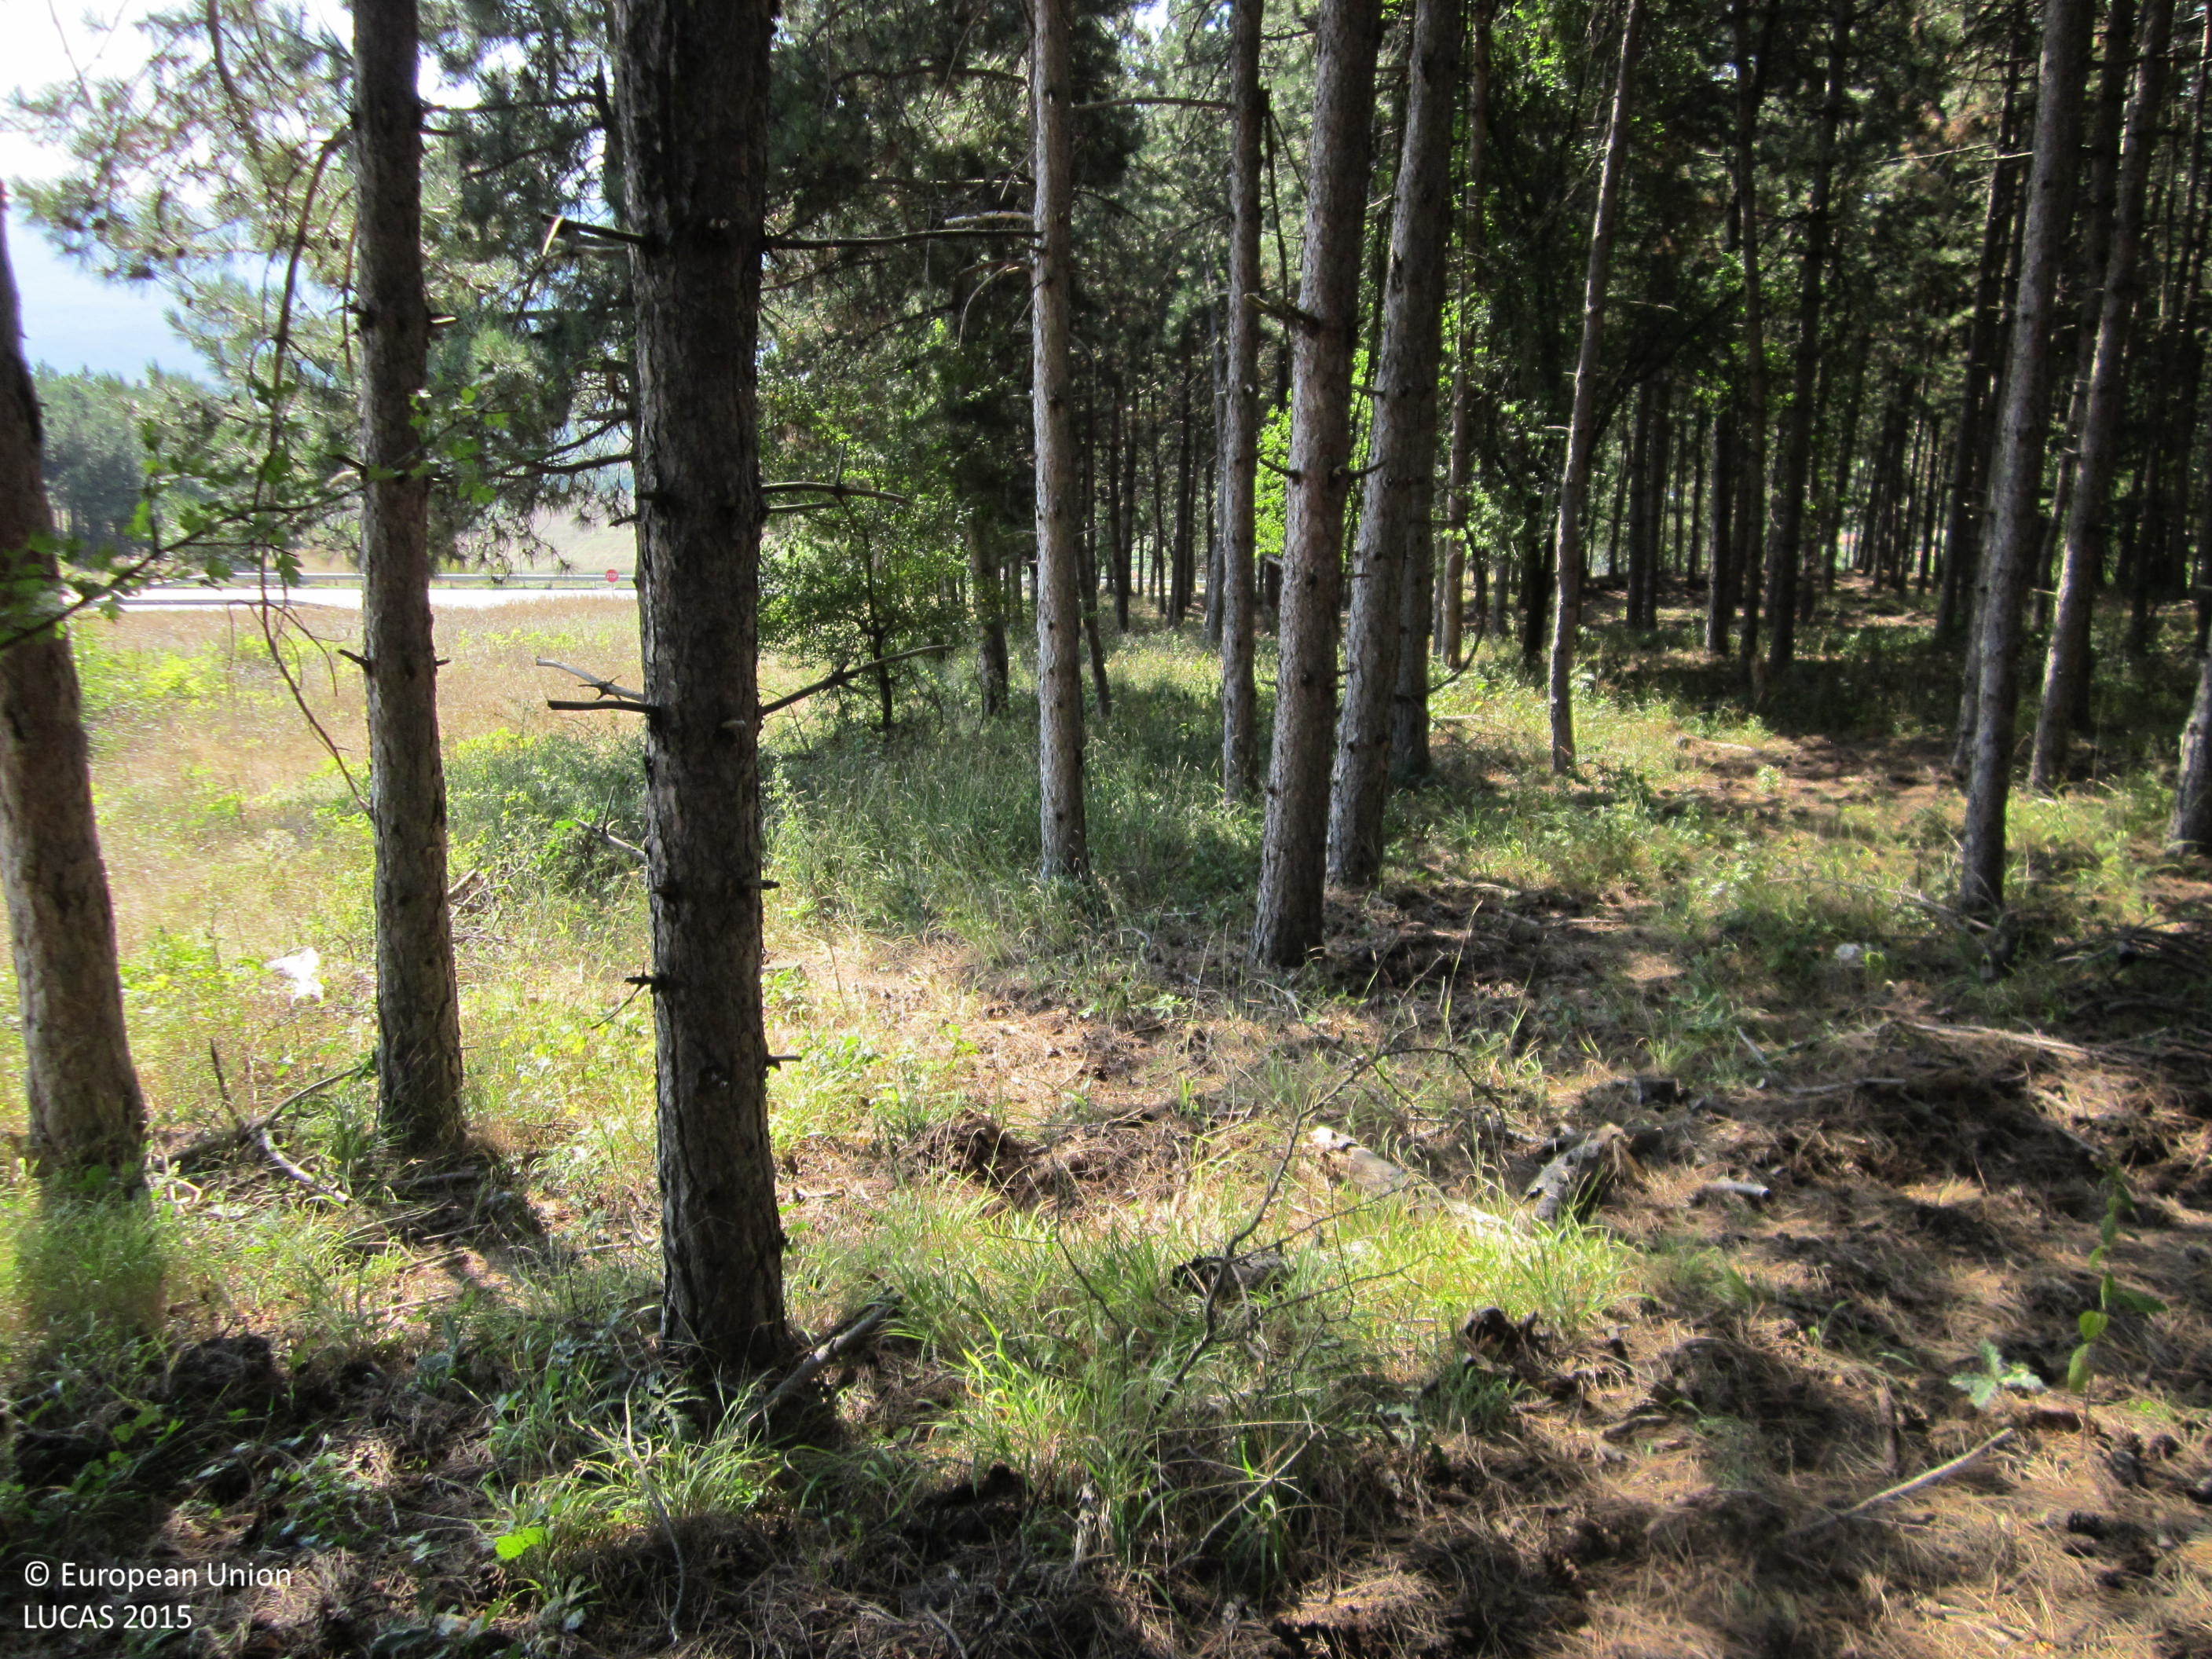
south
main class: Woodland
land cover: Pine dominated coniferous woodland
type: hemiboreal forest and nemoral coniferous forest and mixed broadleaved-coniferous forest
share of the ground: > 75 %
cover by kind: coniferous forest trees 90 %, unconsolidated bare surface 10 %
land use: Forestry
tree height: > 5 m
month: September
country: BG
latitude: 42.8542
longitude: 26.9347
